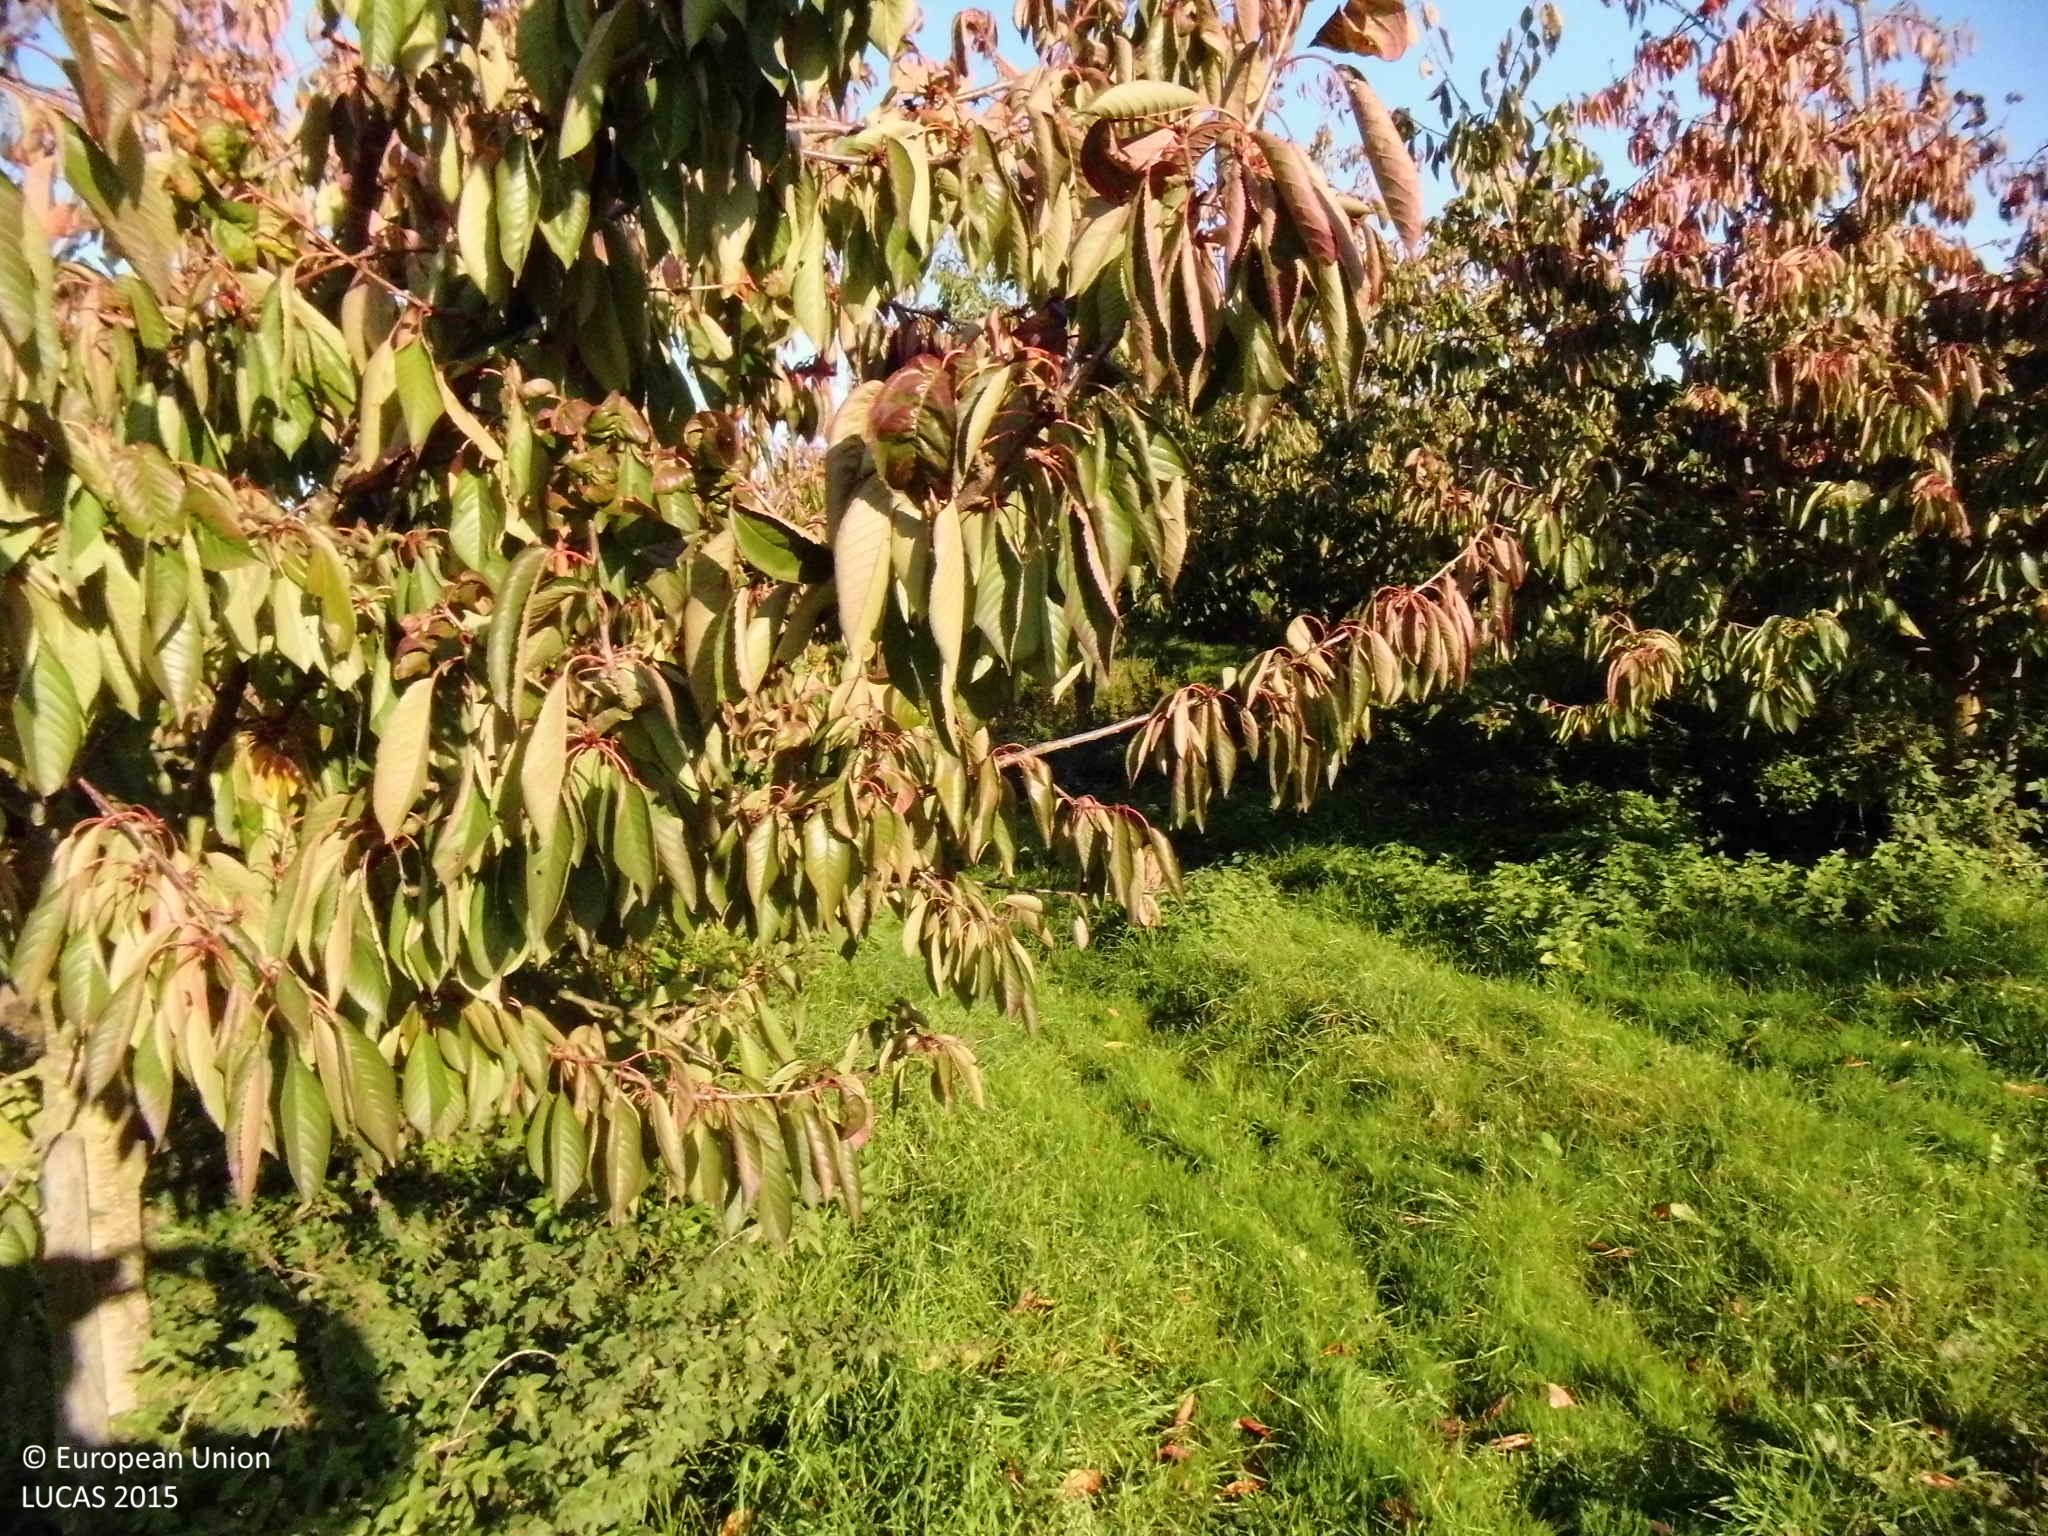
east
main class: Cropland
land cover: Cherry fruit
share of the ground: 25 - 50 %
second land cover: Grassland without tree/shrub cover
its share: > 75 %
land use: Agriculture (excluding fallow land and kitchen gardens)
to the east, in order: Cherry fruit; Grassland without tree/shrub cover; Tracks; Cherry fruit; Other fruit trees and berries; Cherry fruit; Grass margins; Shrubland without tree cover; Grassland without tree/shrub cover; Cherry fruit
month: September
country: DE
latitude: 50.3724
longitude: 7.4835
